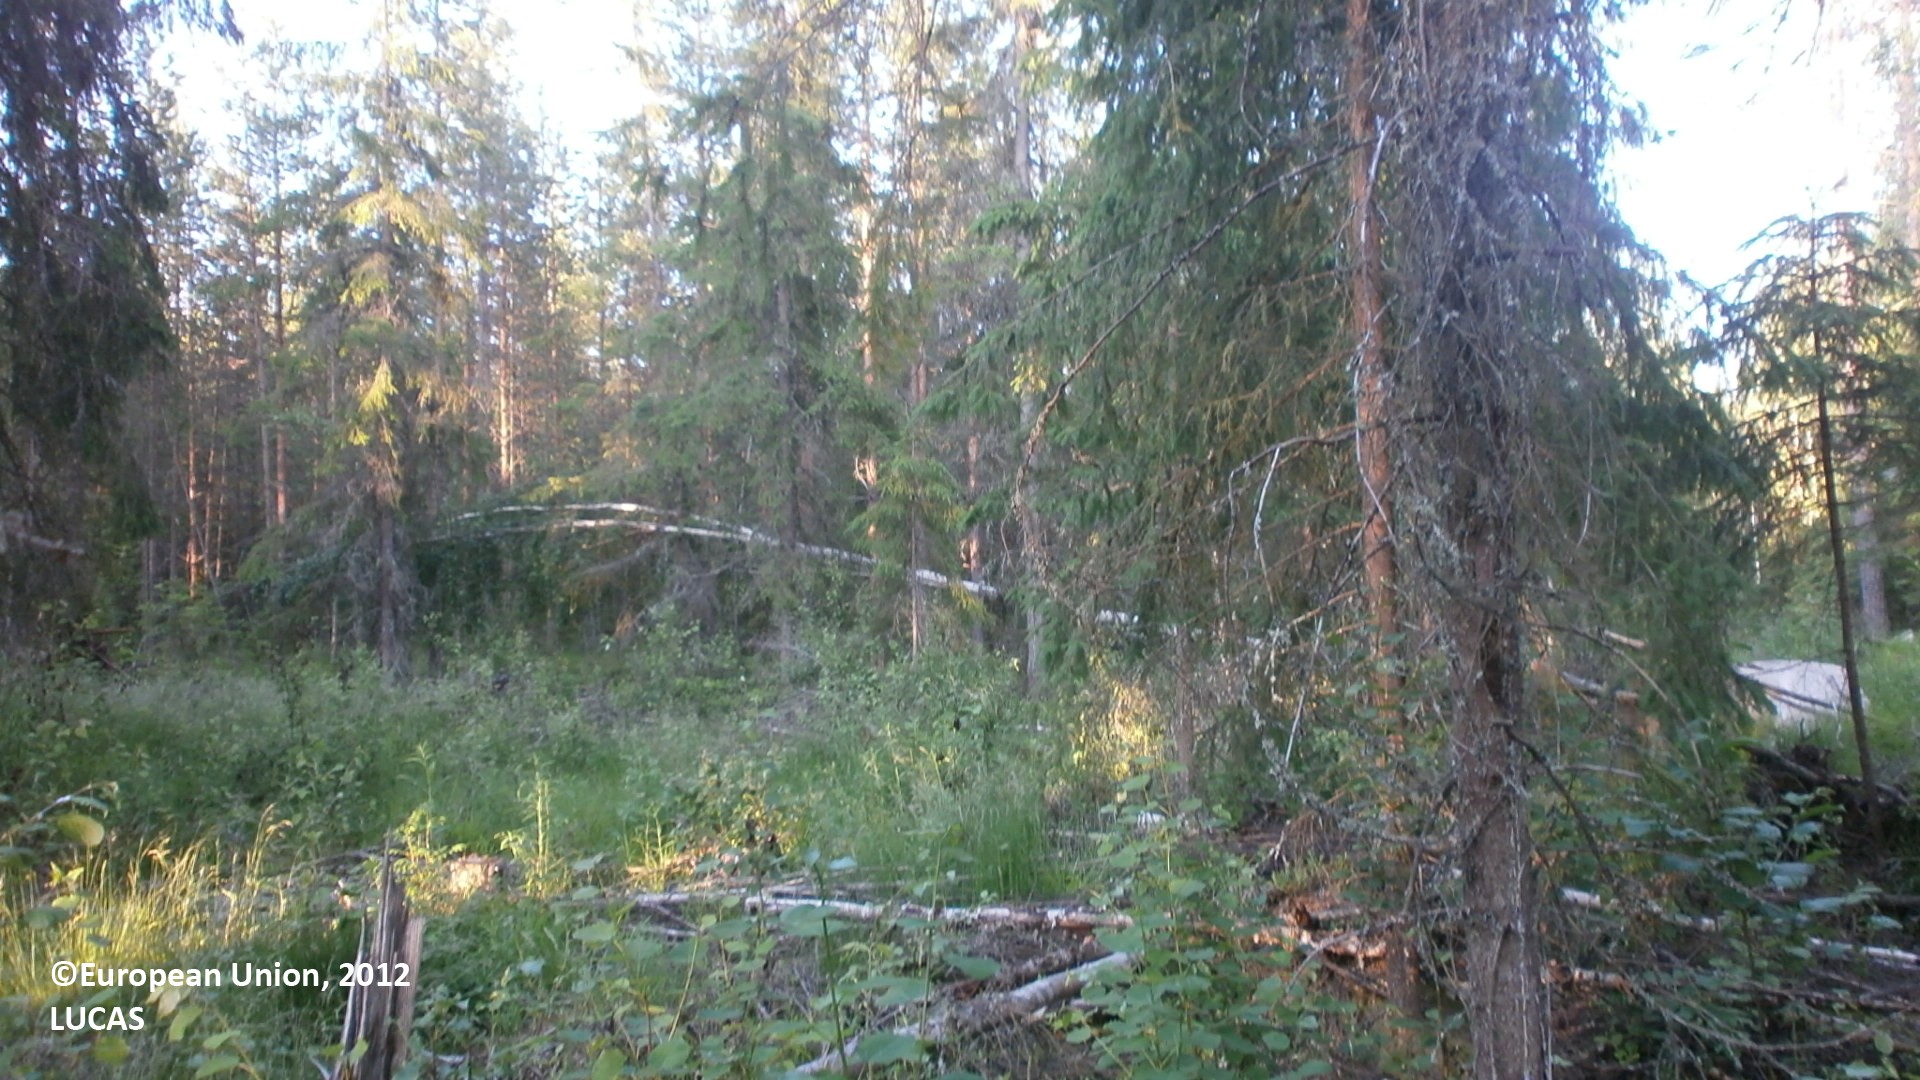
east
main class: Woodland
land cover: Spruce dominated coniferous woodland
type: boreal forest
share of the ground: 50 - 75 %
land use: Forestry
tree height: > 5 m
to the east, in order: Spruce dominated coniferous woodland; Pine dominated mixed woodland; Spruce dominated mixed woodland; Pine dominated mixed woodland; Spruce dominated coniferous woodland; Spruce dominated mixed woodland
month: July
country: FI
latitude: 64.0700
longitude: 24.7758
